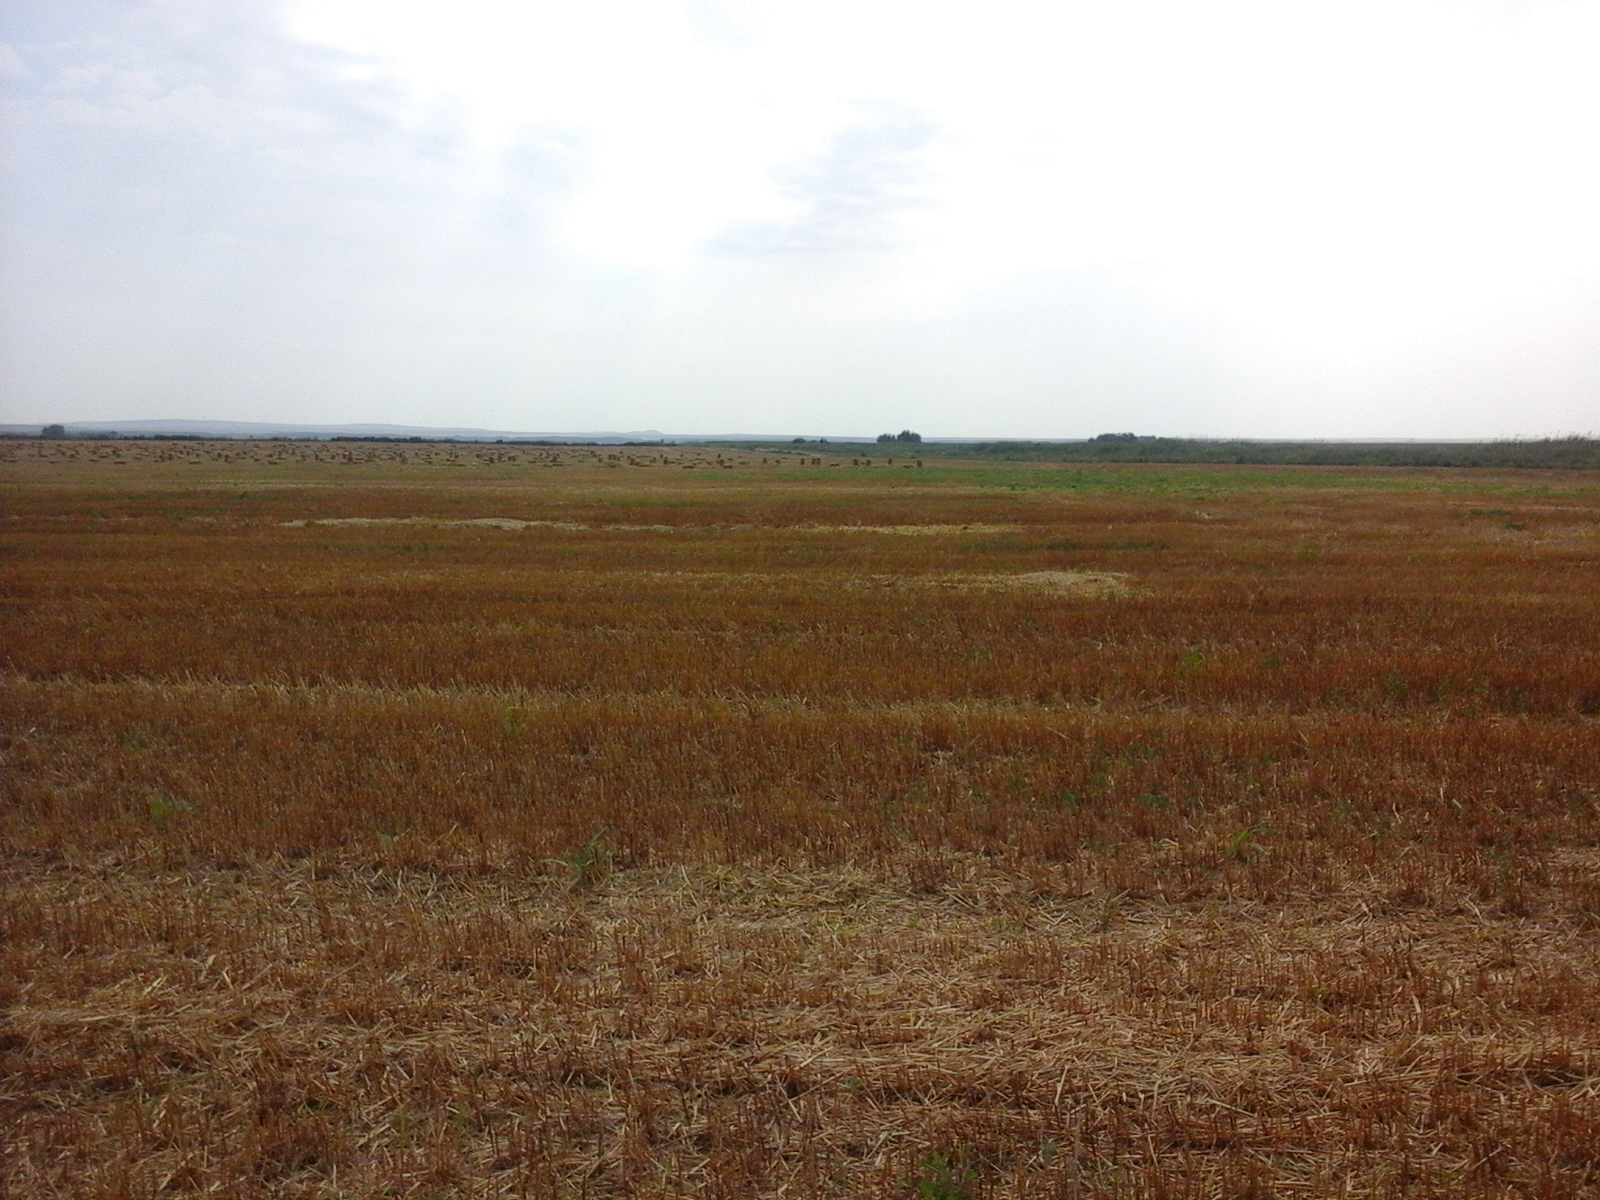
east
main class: Cropland
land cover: Common wheat
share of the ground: > 75 %
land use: Agriculture (excluding fallow land and kitchen gardens)
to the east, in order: Common wheat
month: July
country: RO
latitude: 44.4763
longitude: 27.9970
